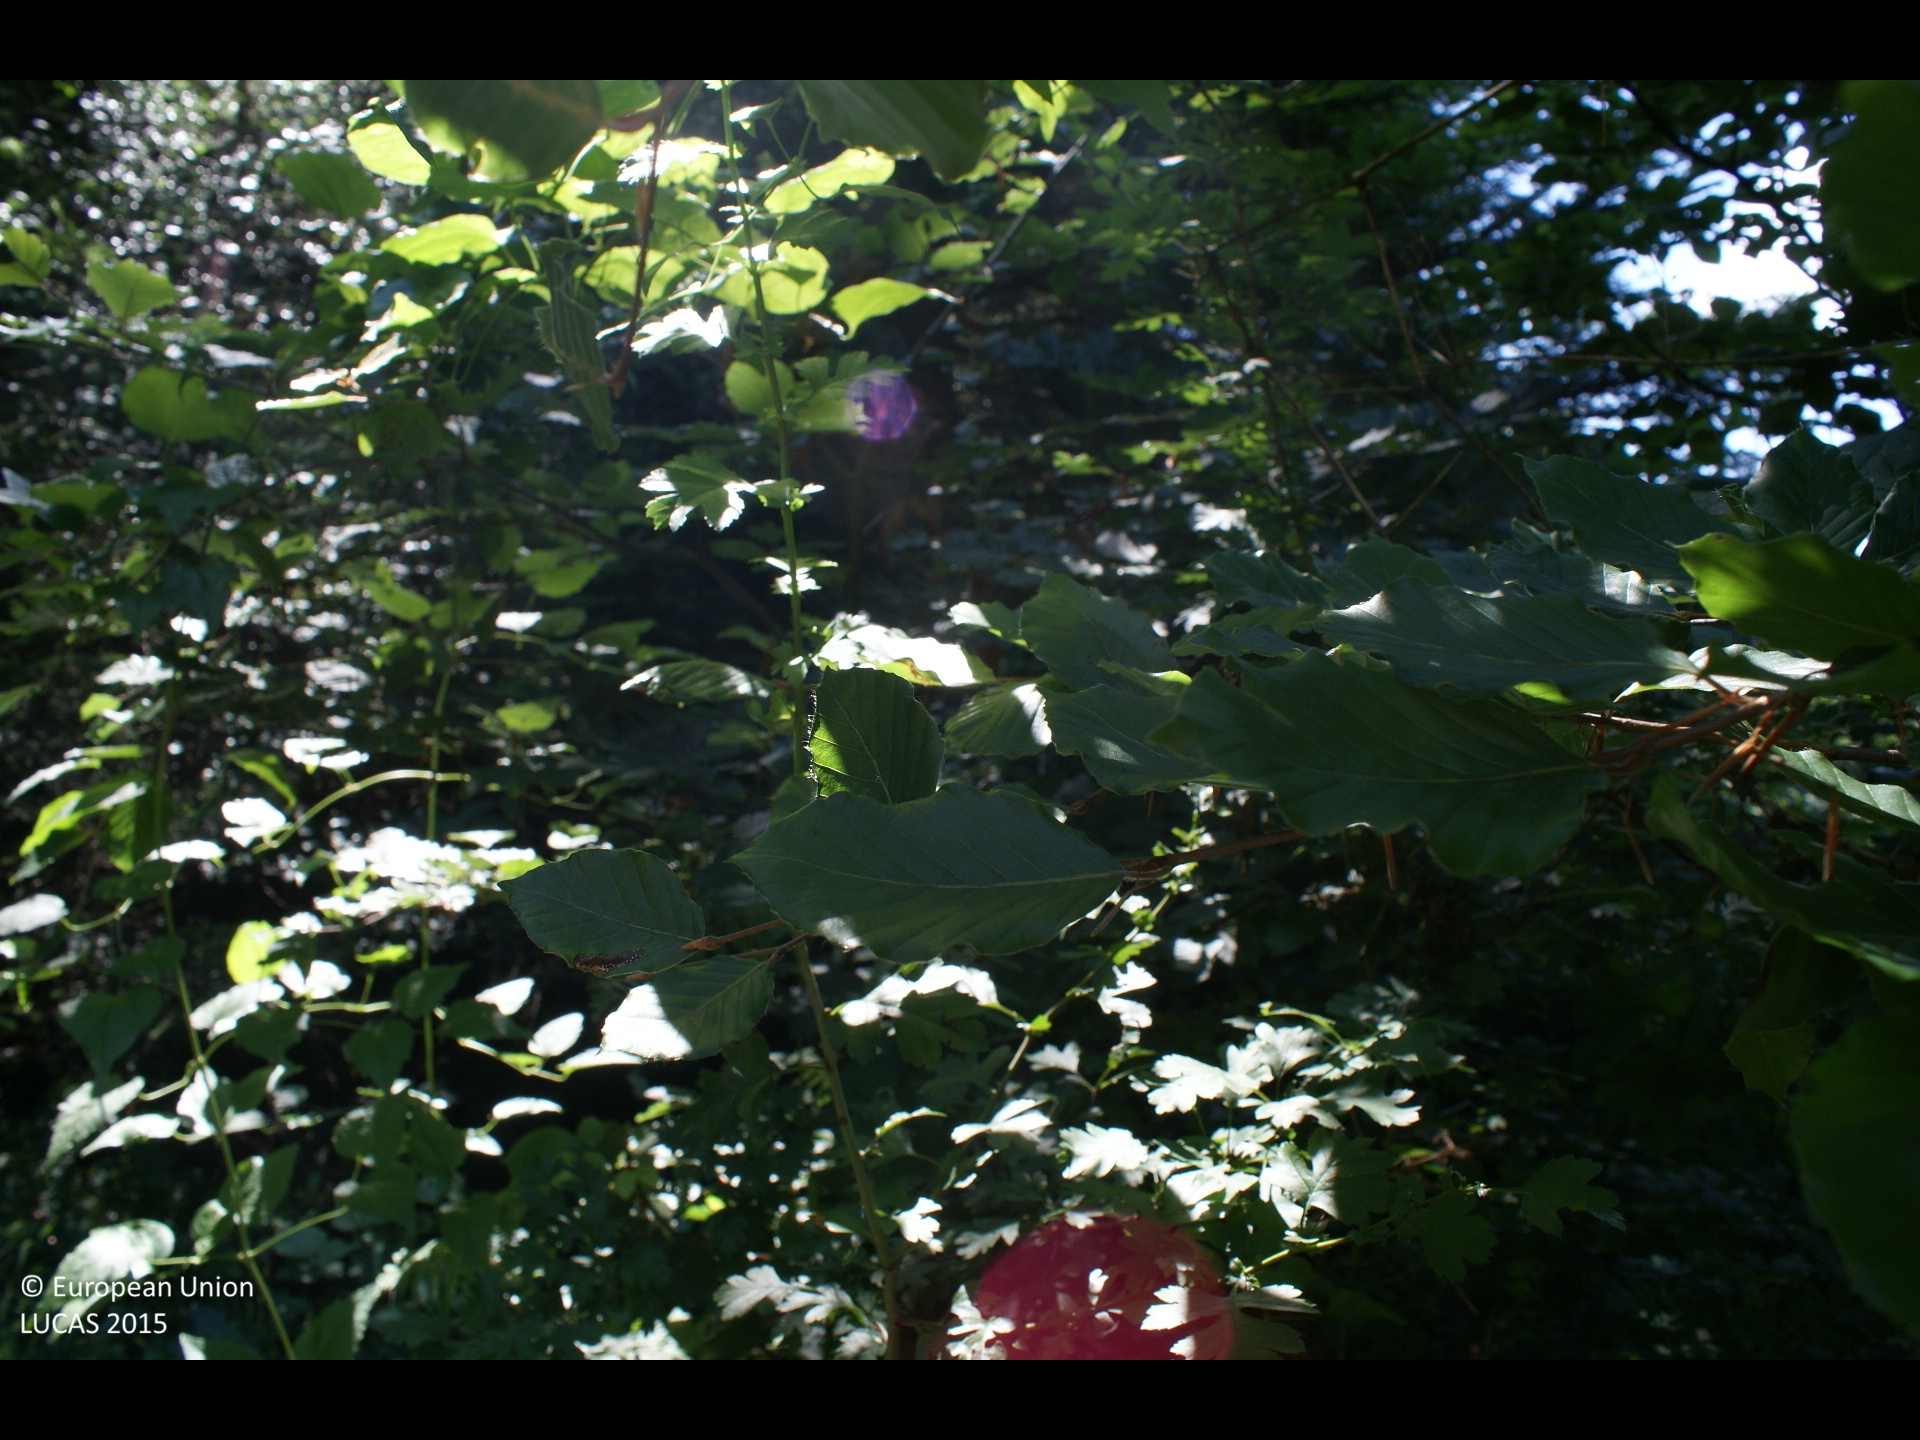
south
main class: Woodland
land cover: Broadleaved woodland
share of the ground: > 75 %
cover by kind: shrubs 40 %, herbaceous plants 30 %, broadleaved forest trees 25 %, coniferous forest trees 5 %
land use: Forestry
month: July
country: AT
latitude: 47.9523
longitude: 15.2905
